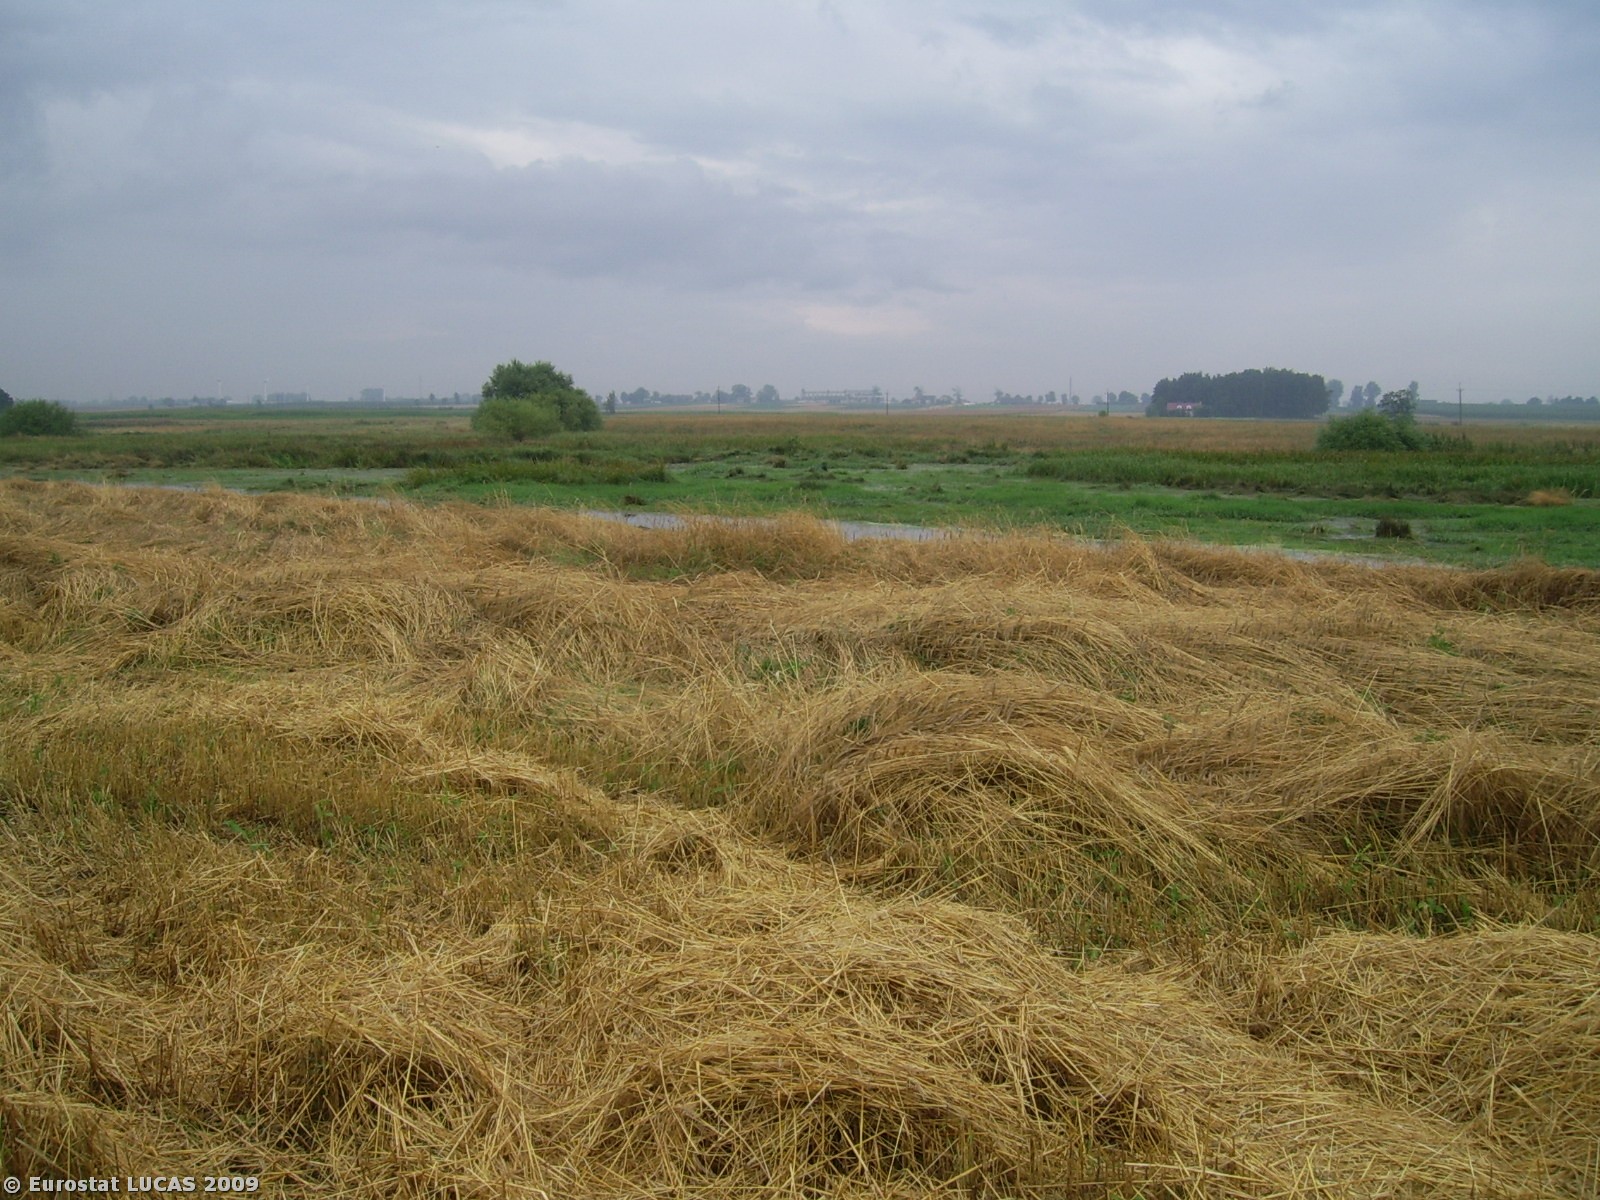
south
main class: Cropland
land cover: Triticale
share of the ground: < 10 %
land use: Agriculture (excluding fallow land and kitchen gardens)
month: August
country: PL
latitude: 52.8171
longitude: 18.7006
